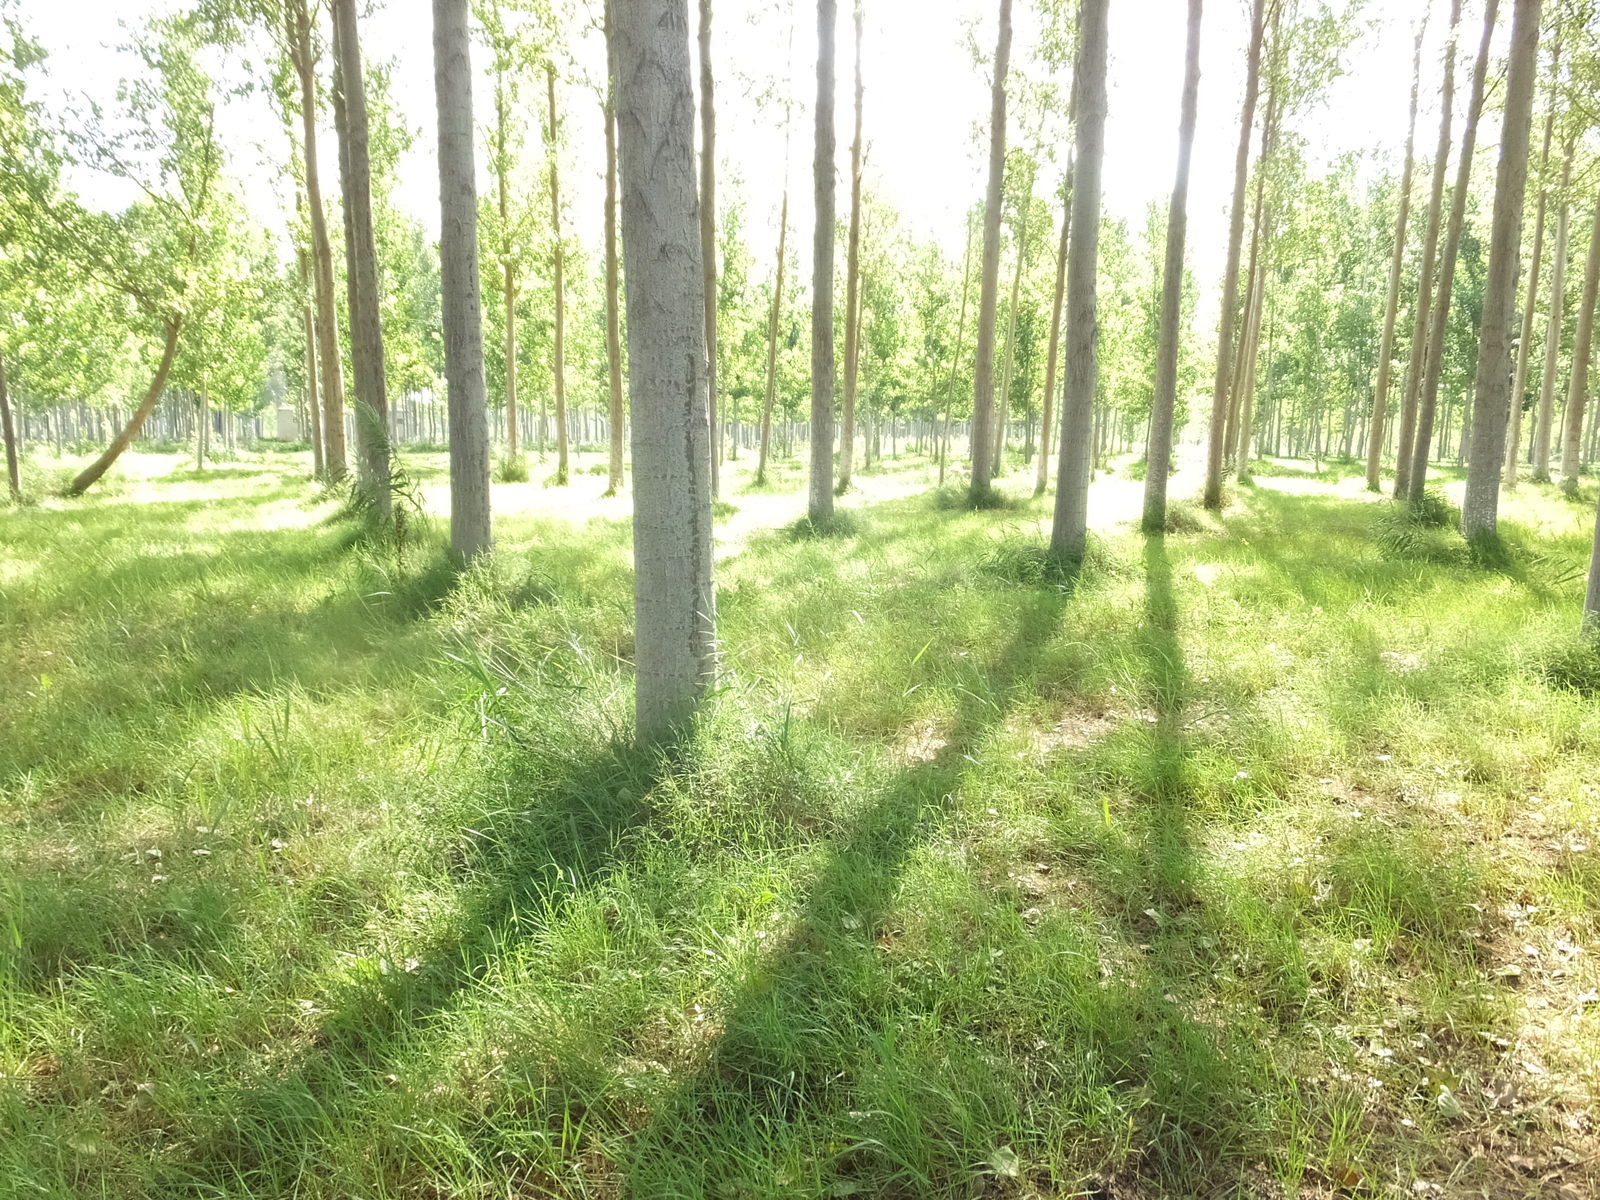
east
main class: Woodland
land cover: Broadleaved woodland
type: broadleaved evergreen forest
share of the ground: > 75 %
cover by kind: broadleaved forest trees 95 %, herbaceous plants 5 %
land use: Forestry
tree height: > 5 m
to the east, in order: Broadleaved woodland; Tracks; Broadleaved woodland; Tracks; Broadleaved woodland; Tracks; Broadleaved woodland
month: July
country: ES
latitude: 41.4741
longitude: 0.4441
